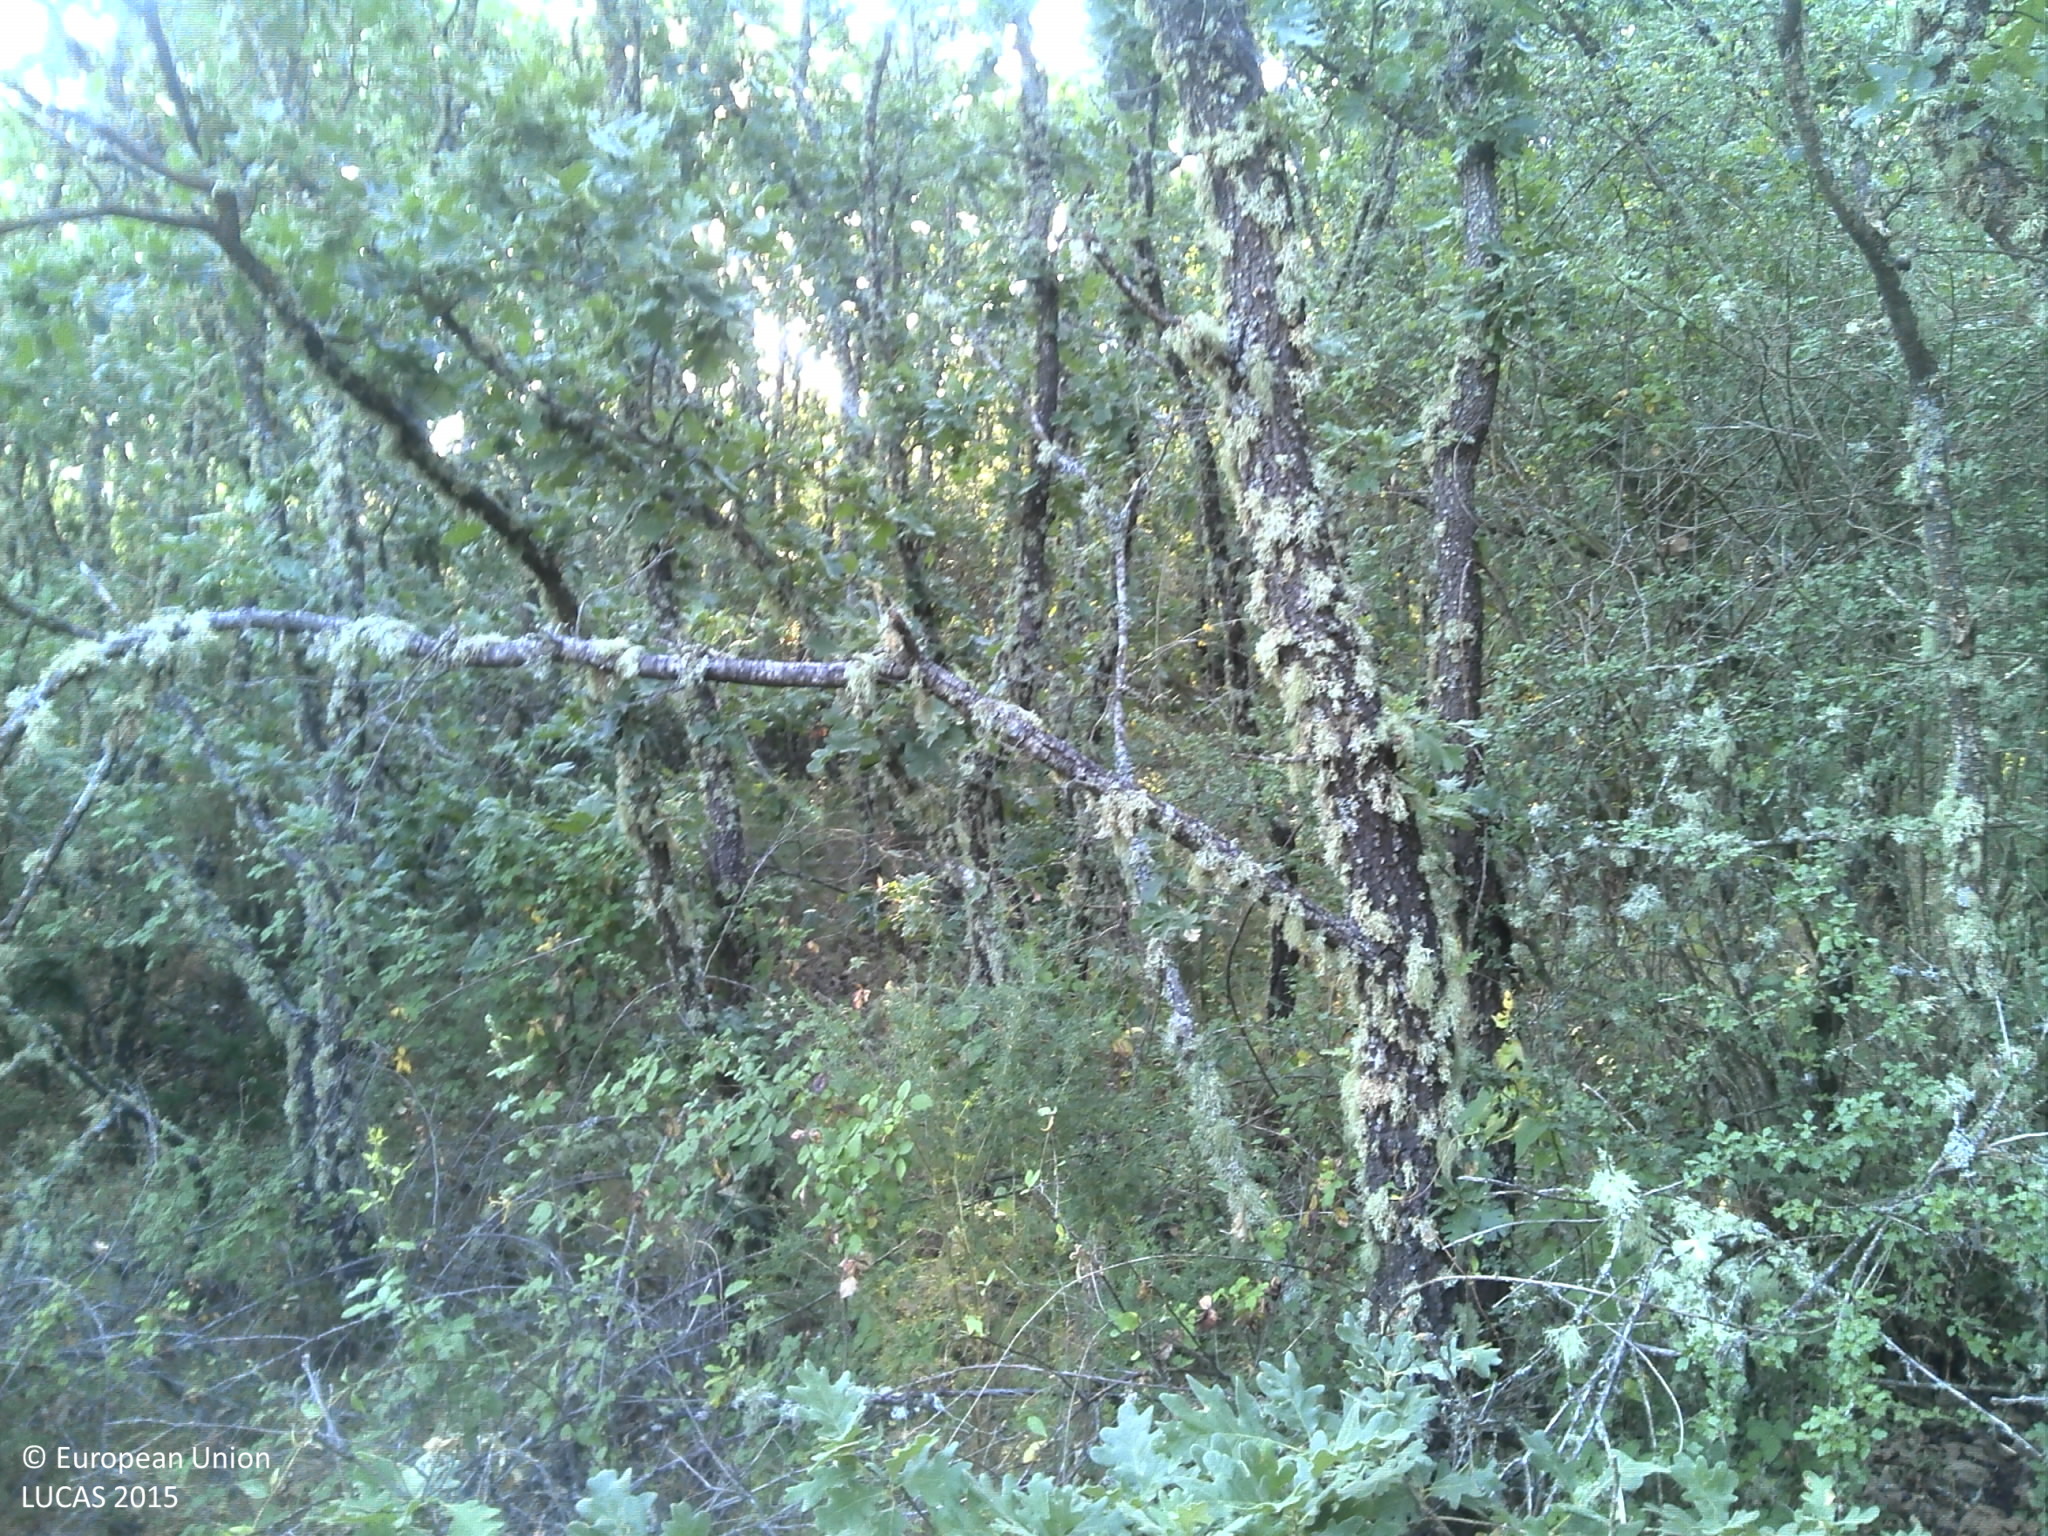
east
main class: Woodland
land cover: Broadleaved woodland
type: acidophilous oak and oak-birch forest
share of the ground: 50 - 75 %
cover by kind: broadleaved forest trees 65 %, shrubs 25 %, unconsolidated bare surface 5 %
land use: Forestry
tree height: > 5 m
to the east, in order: Broadleaved woodland; Other bare soil; Cherry fruit; Dry stone walls; Cherry fruit; Dry stone walls; Tracks; Electric lines; Shrubland without tree cover
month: June
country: PT
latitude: 40.2320
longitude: -7.3926
